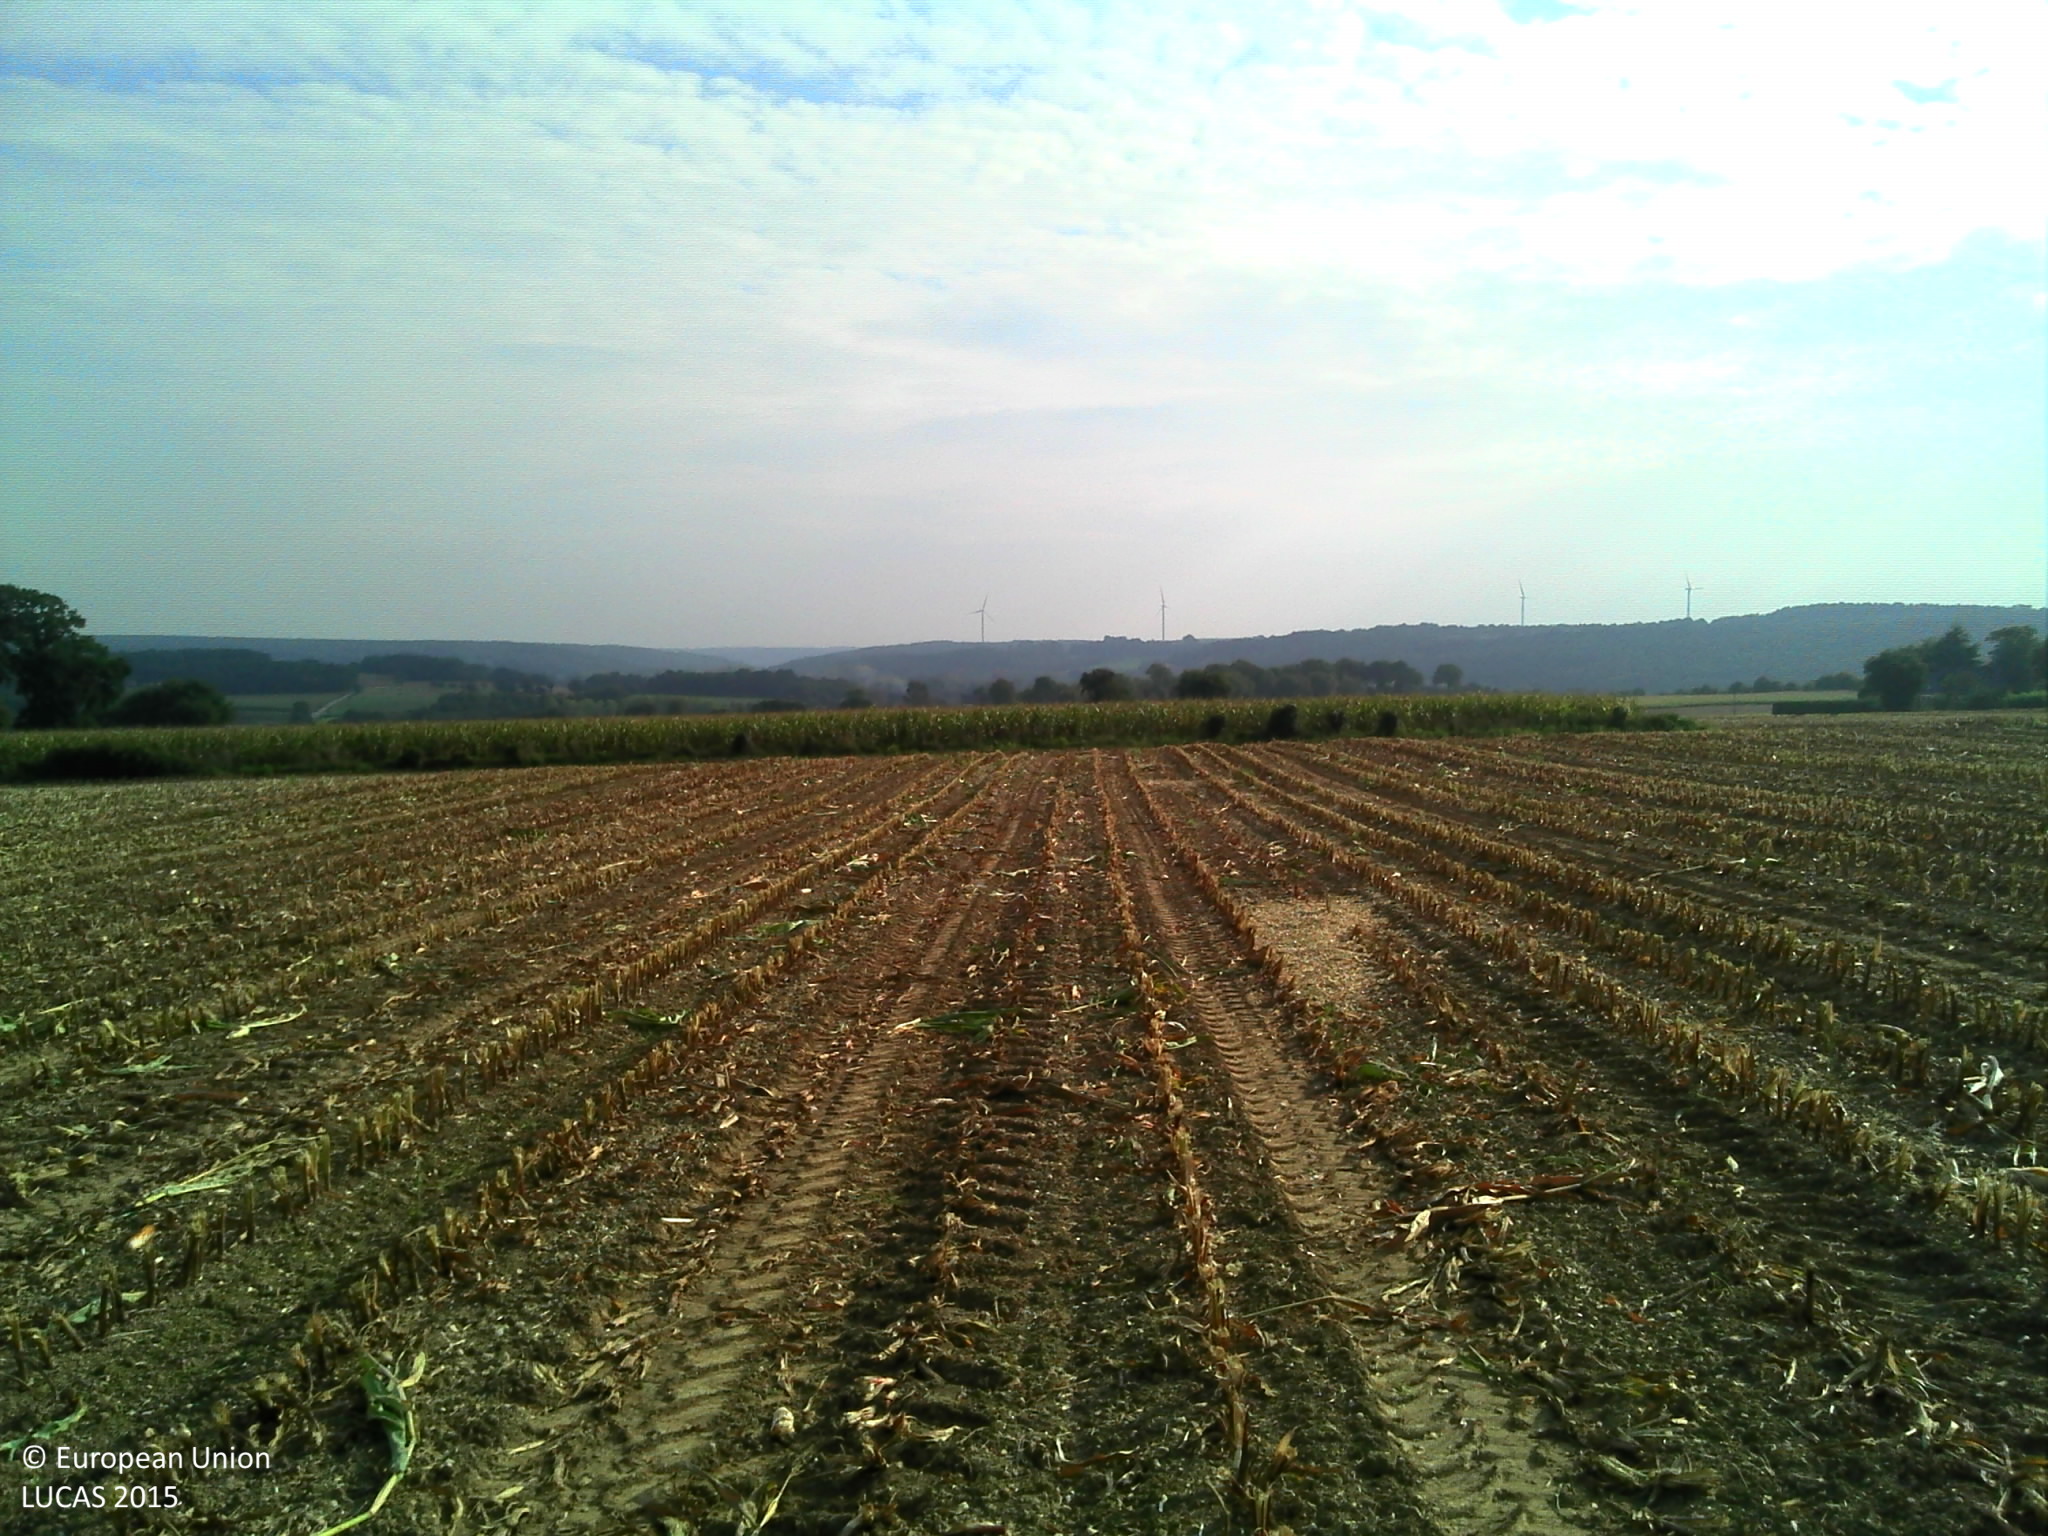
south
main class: Cropland
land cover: Maize
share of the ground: < 10 %
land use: Agriculture (excluding fallow land and kitchen gardens)
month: October
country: FR
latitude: 47.8194
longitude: -2.3304
